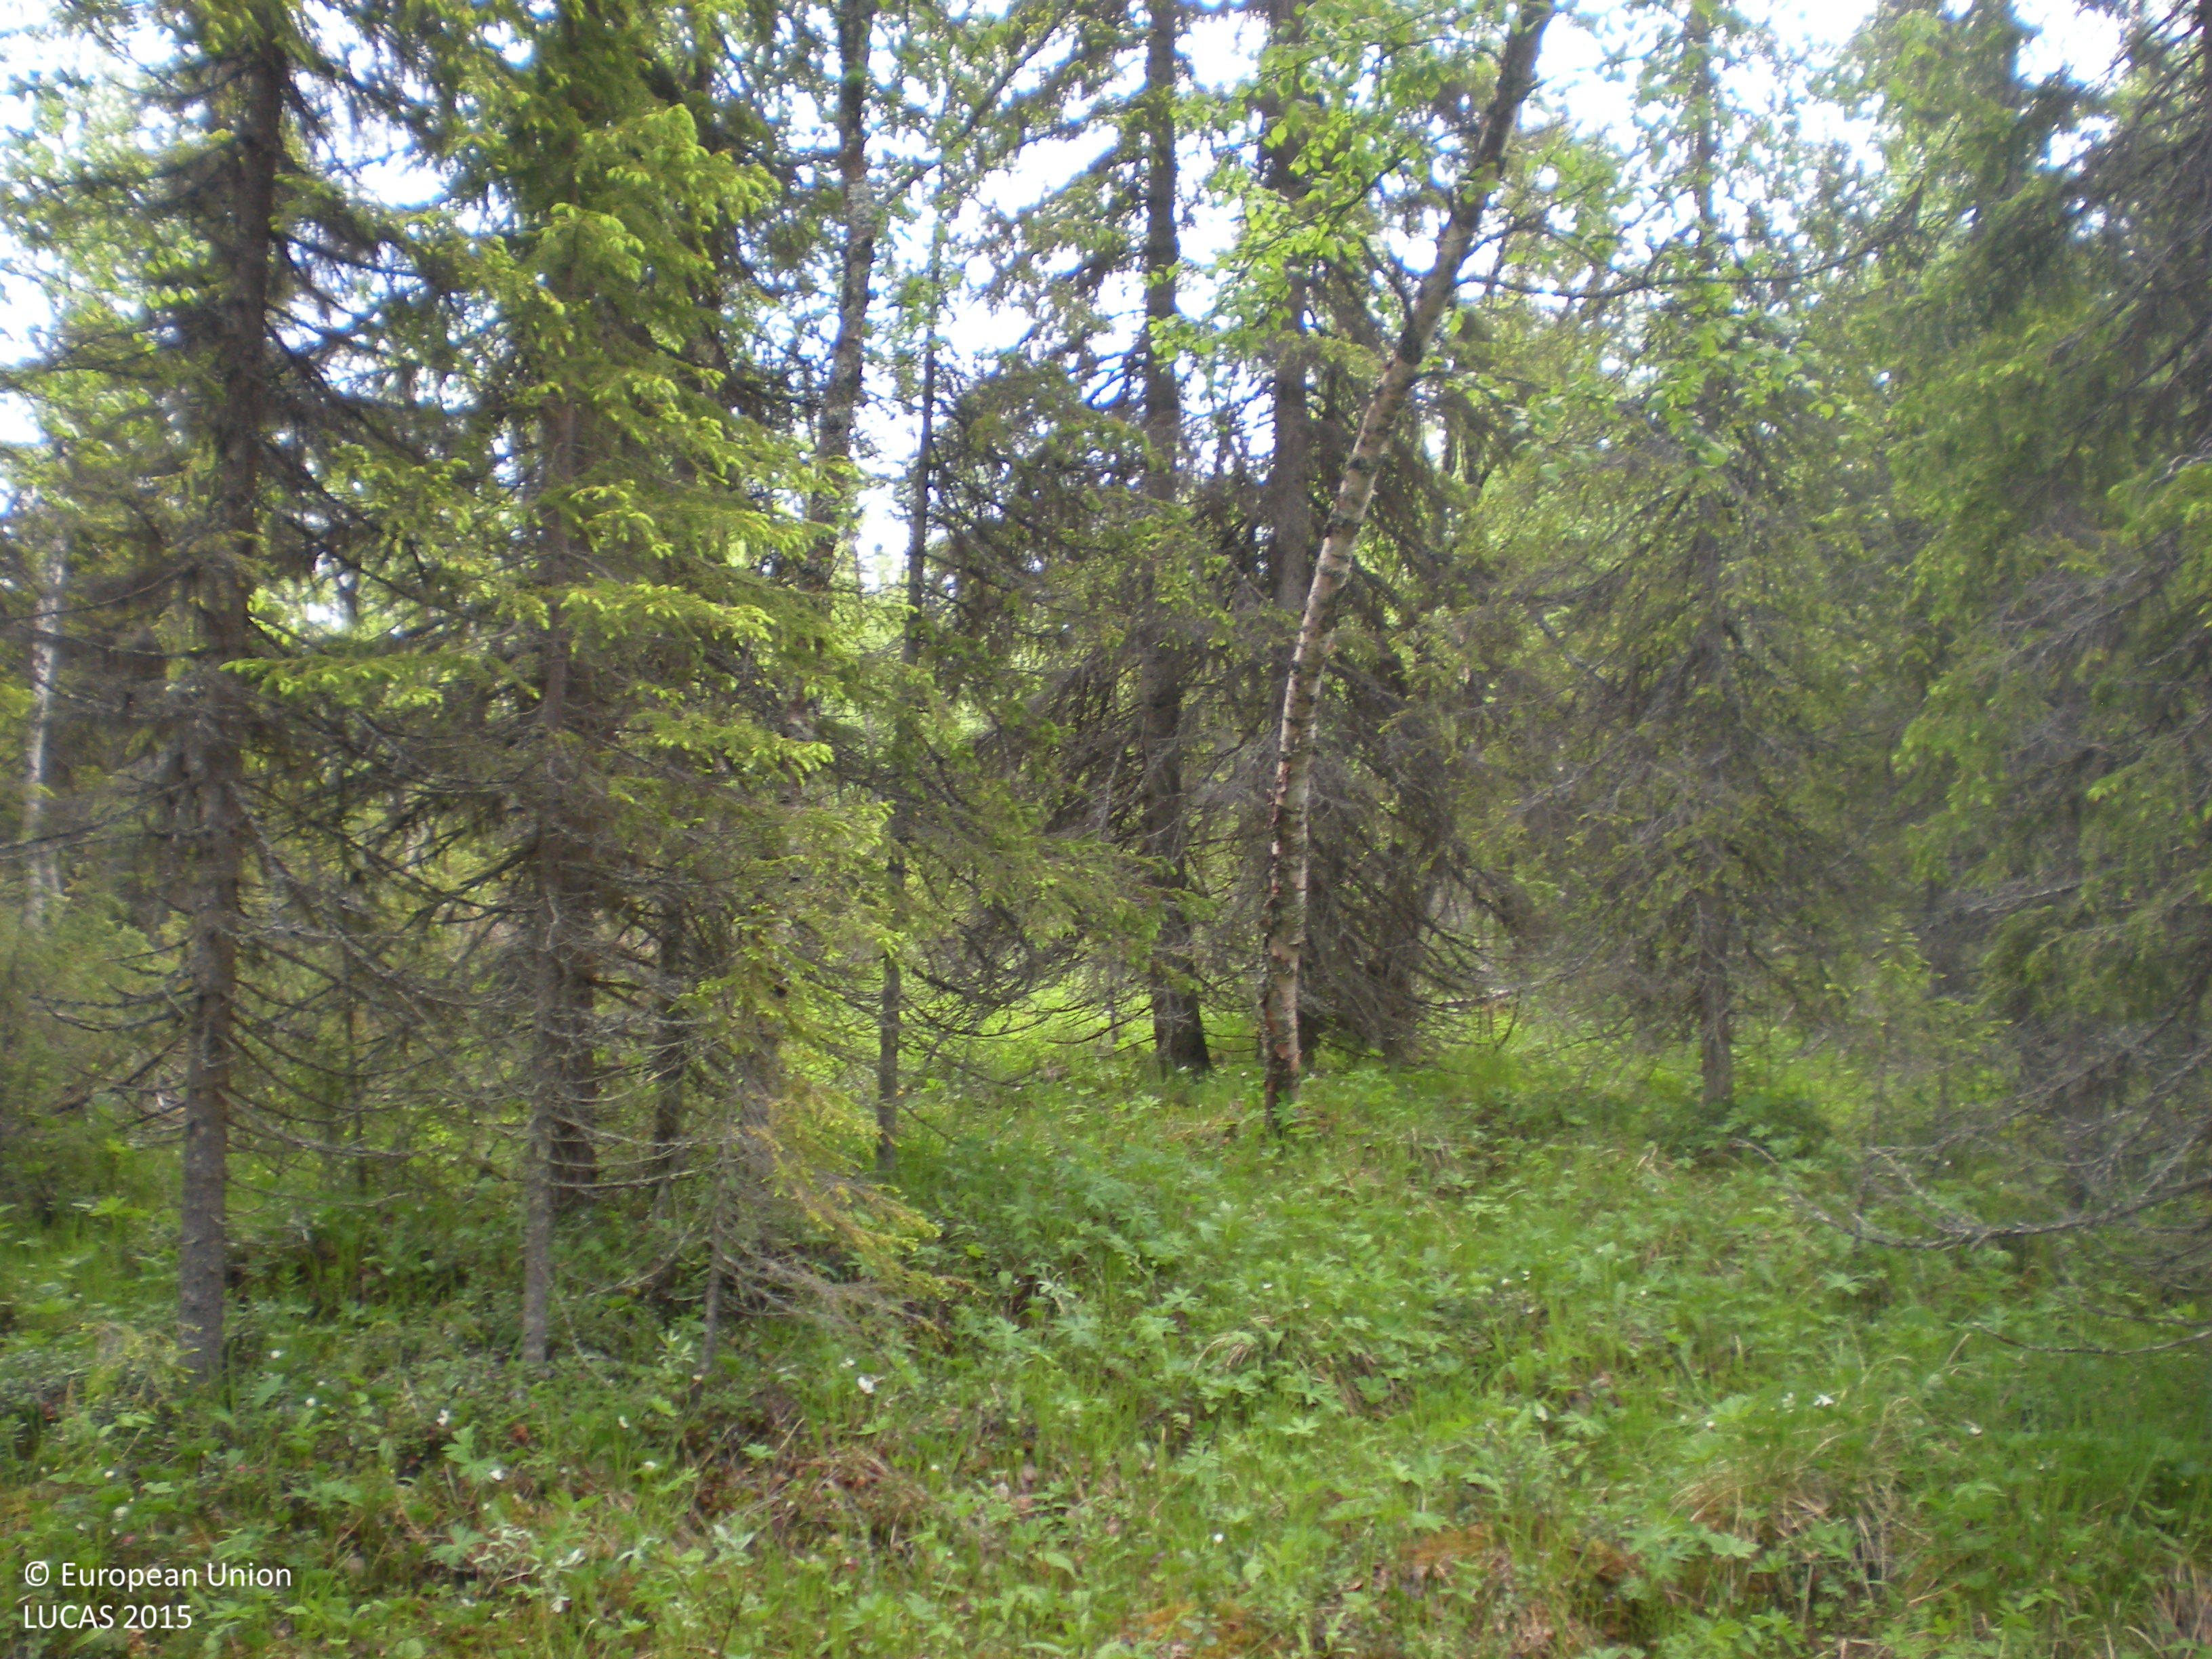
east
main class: Woodland
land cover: Spruce dominated mixed woodland
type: boreal forest
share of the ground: 50 - 75 %
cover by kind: coniferous forest trees 50 %, broadleaved forest trees 20 %, shrubs 15 %, herbaceous plants 10 %, lichens and mosses 5 %
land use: Forestry
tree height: > 5 m
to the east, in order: Tracks; Spruce dominated mixed woodland; Ditches and canals; Spruce dominated mixed woodland
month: July
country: SE
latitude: 66.0874
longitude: 17.1854
